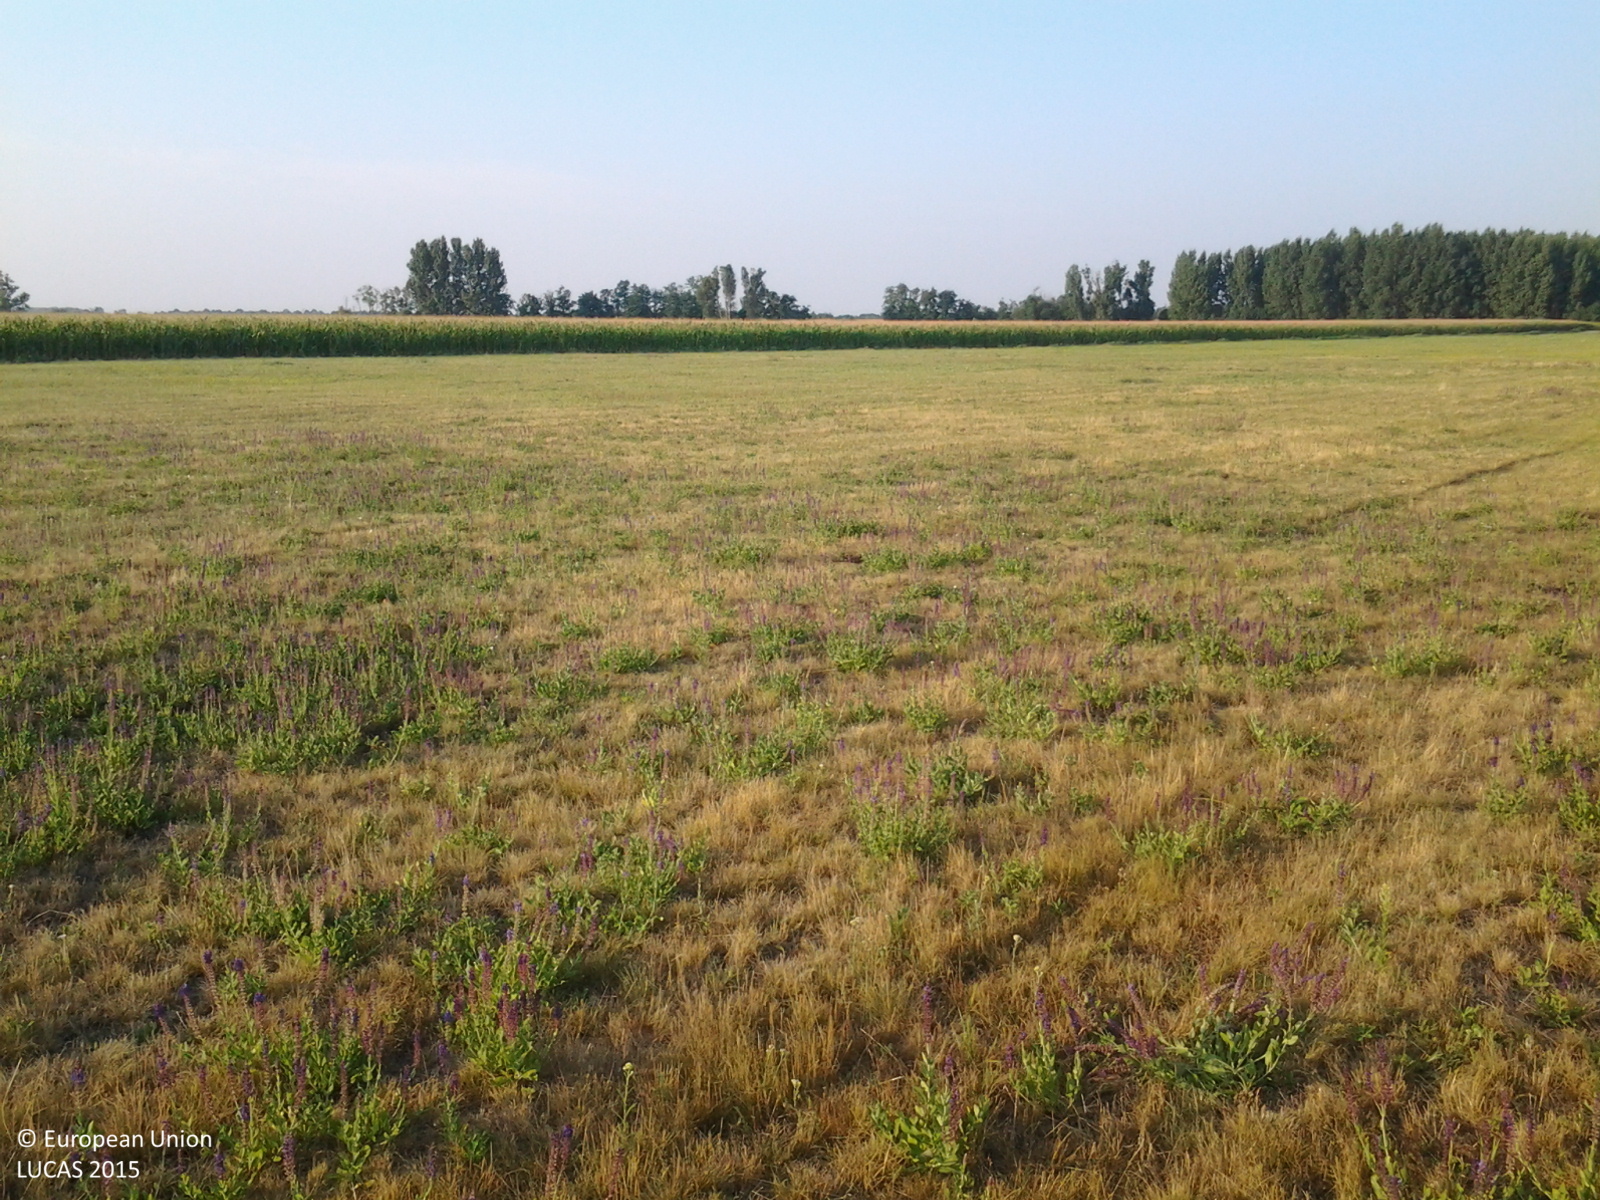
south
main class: Grassland
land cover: Grassland without tree/shrub cover
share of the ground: > 75 %
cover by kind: herbaceous plants 100 %
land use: Agriculture (excluding fallow land and kitchen gardens)
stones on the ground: < 10 %
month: July
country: HU
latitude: 46.9017
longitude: 20.8887
